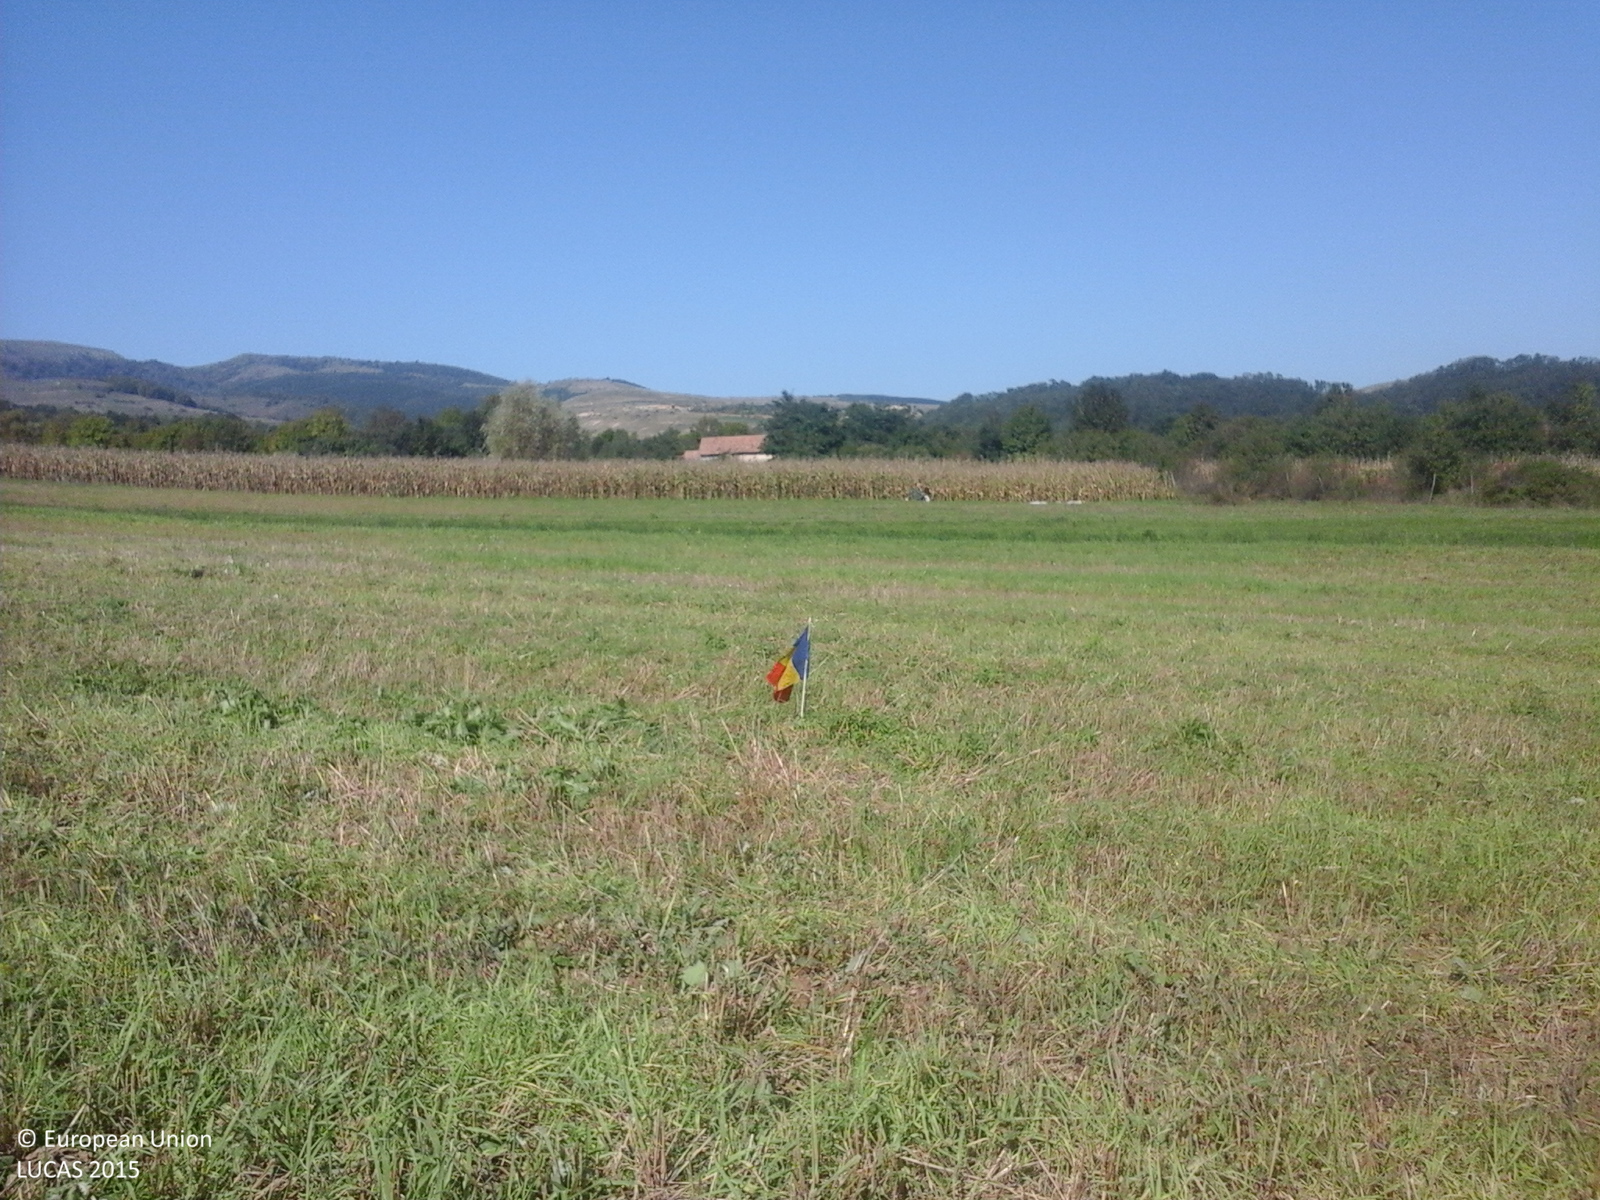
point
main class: Grassland
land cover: Grassland without tree/shrub cover
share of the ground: > 75 %
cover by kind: herbaceous plants 100 %
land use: Agriculture (excluding fallow land and kitchen gardens)
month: October
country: RO
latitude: 46.4217
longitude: 23.6408
